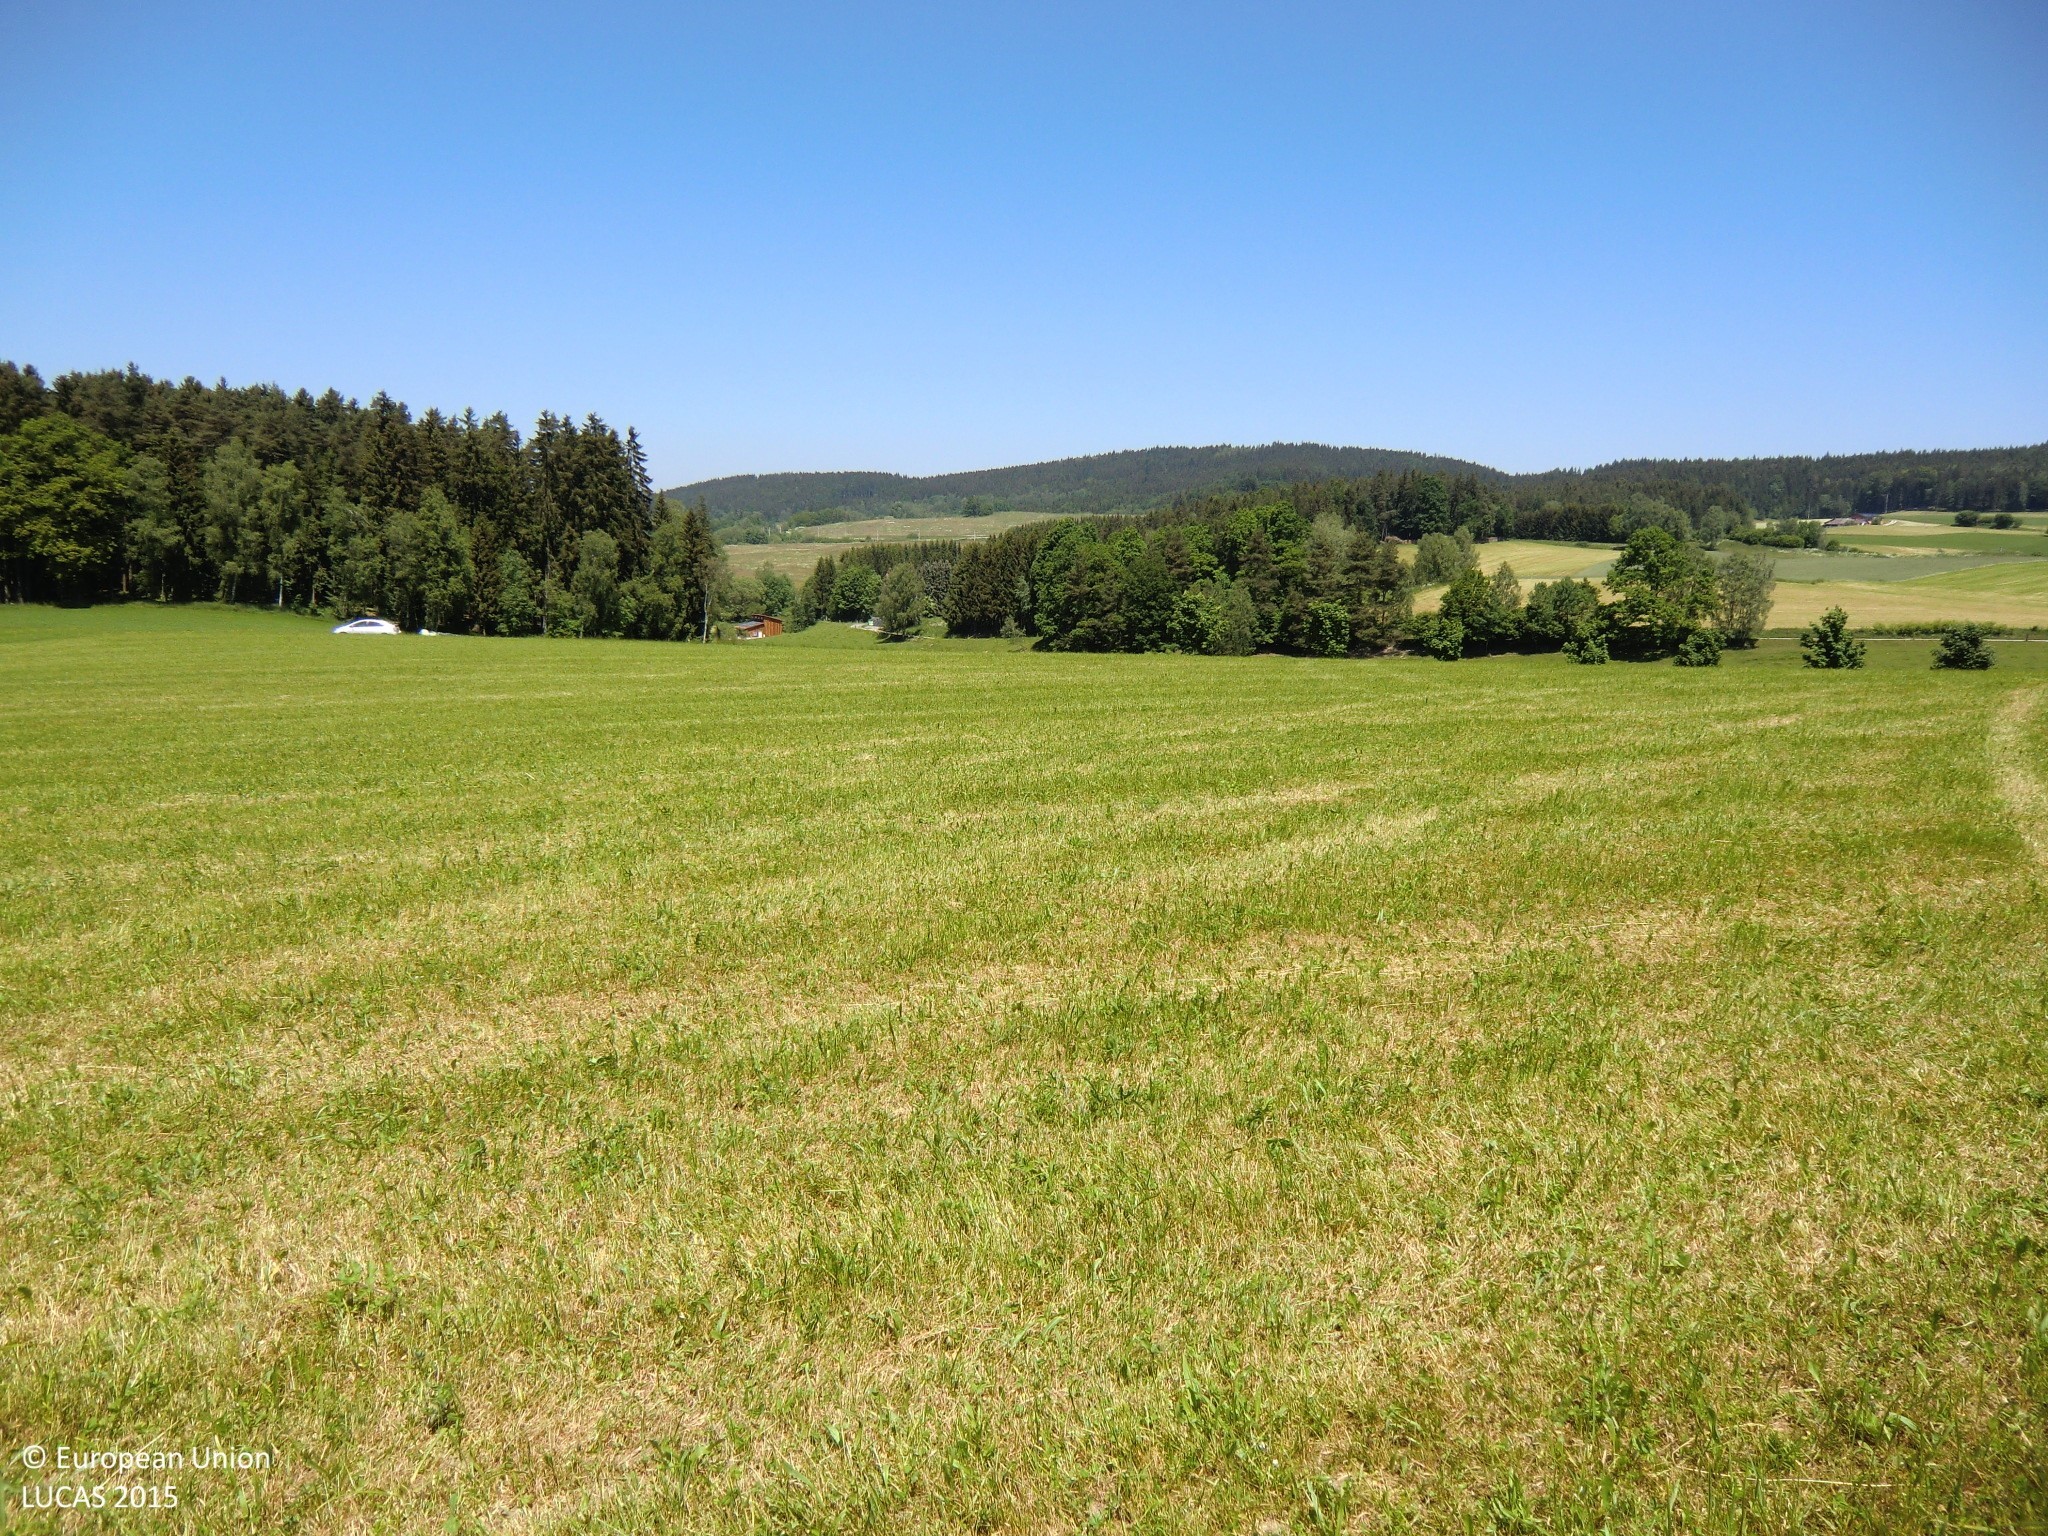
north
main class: Grassland
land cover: Grassland without tree/shrub cover
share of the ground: > 75 %
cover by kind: herbaceous plants 100 %
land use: Agriculture (excluding fallow land and kitchen gardens)
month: June
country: AT
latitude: 48.5849
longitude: 14.4336
